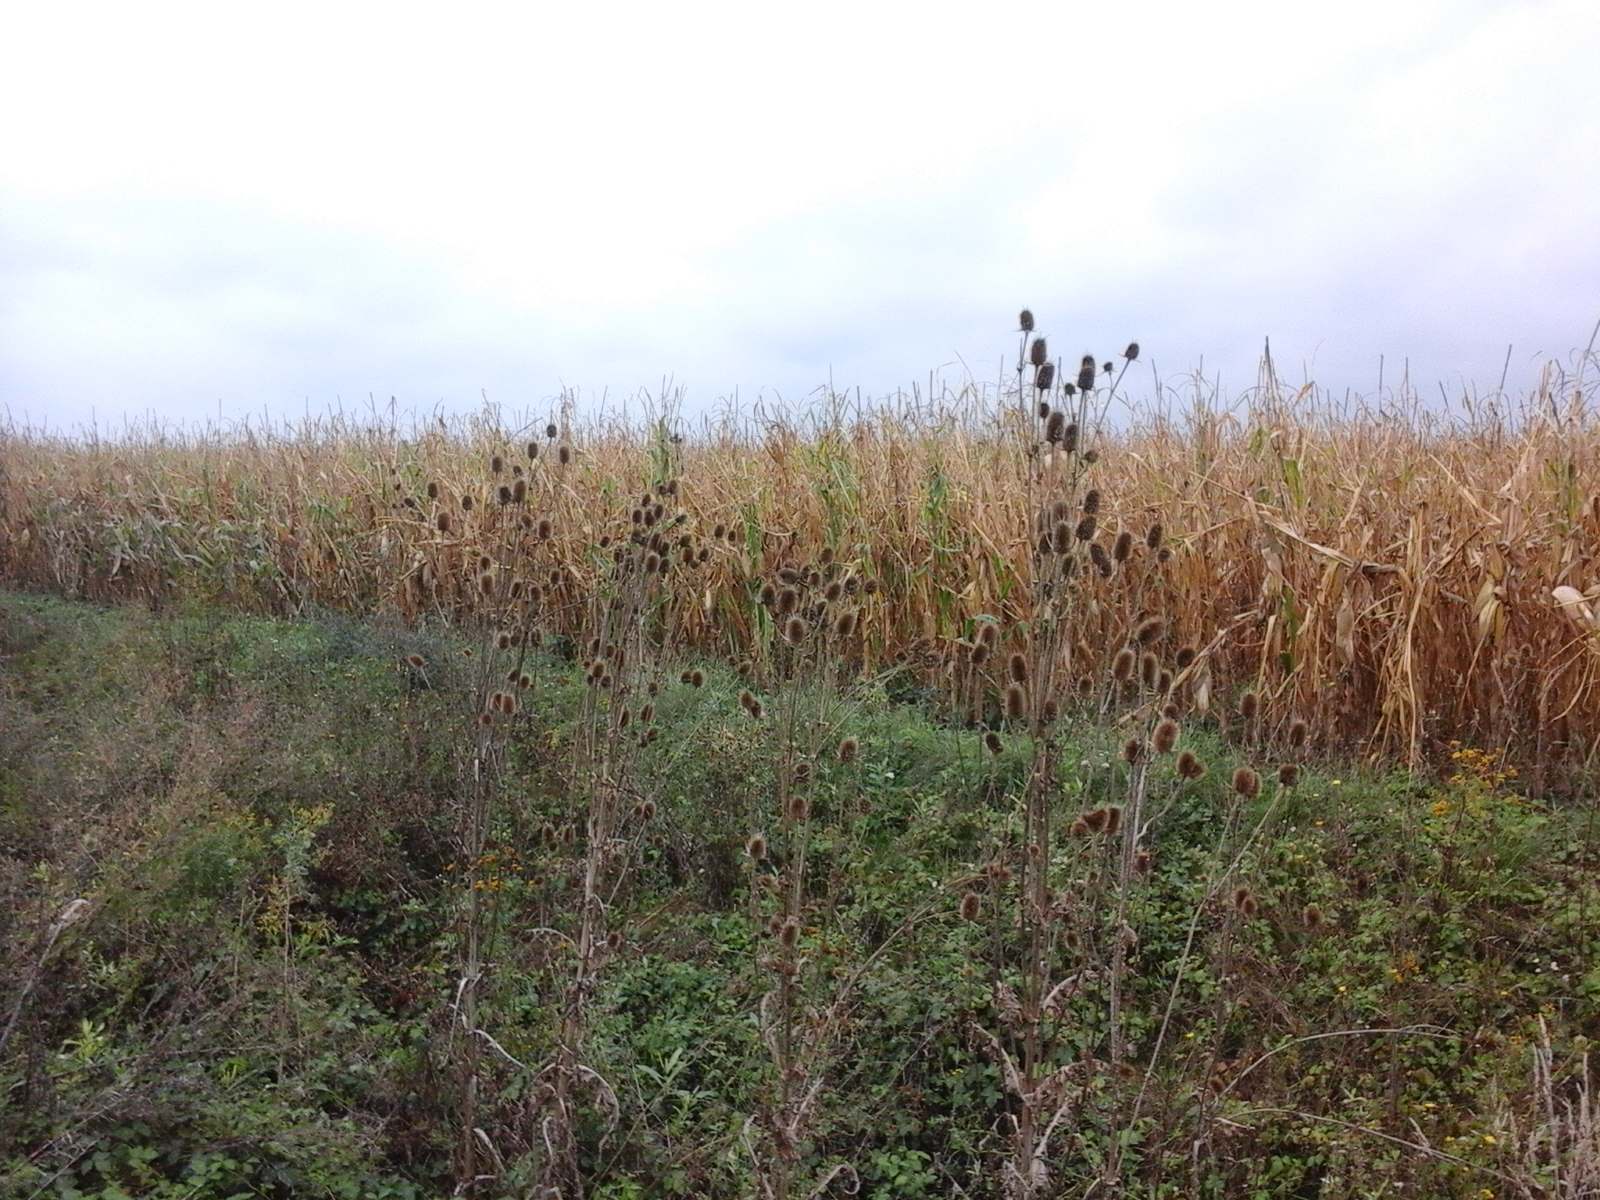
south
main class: Cropland
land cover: Maize
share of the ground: > 75 %
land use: Agriculture (excluding fallow land and kitchen gardens)
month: September
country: RO
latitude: 47.0952
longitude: 21.8097
